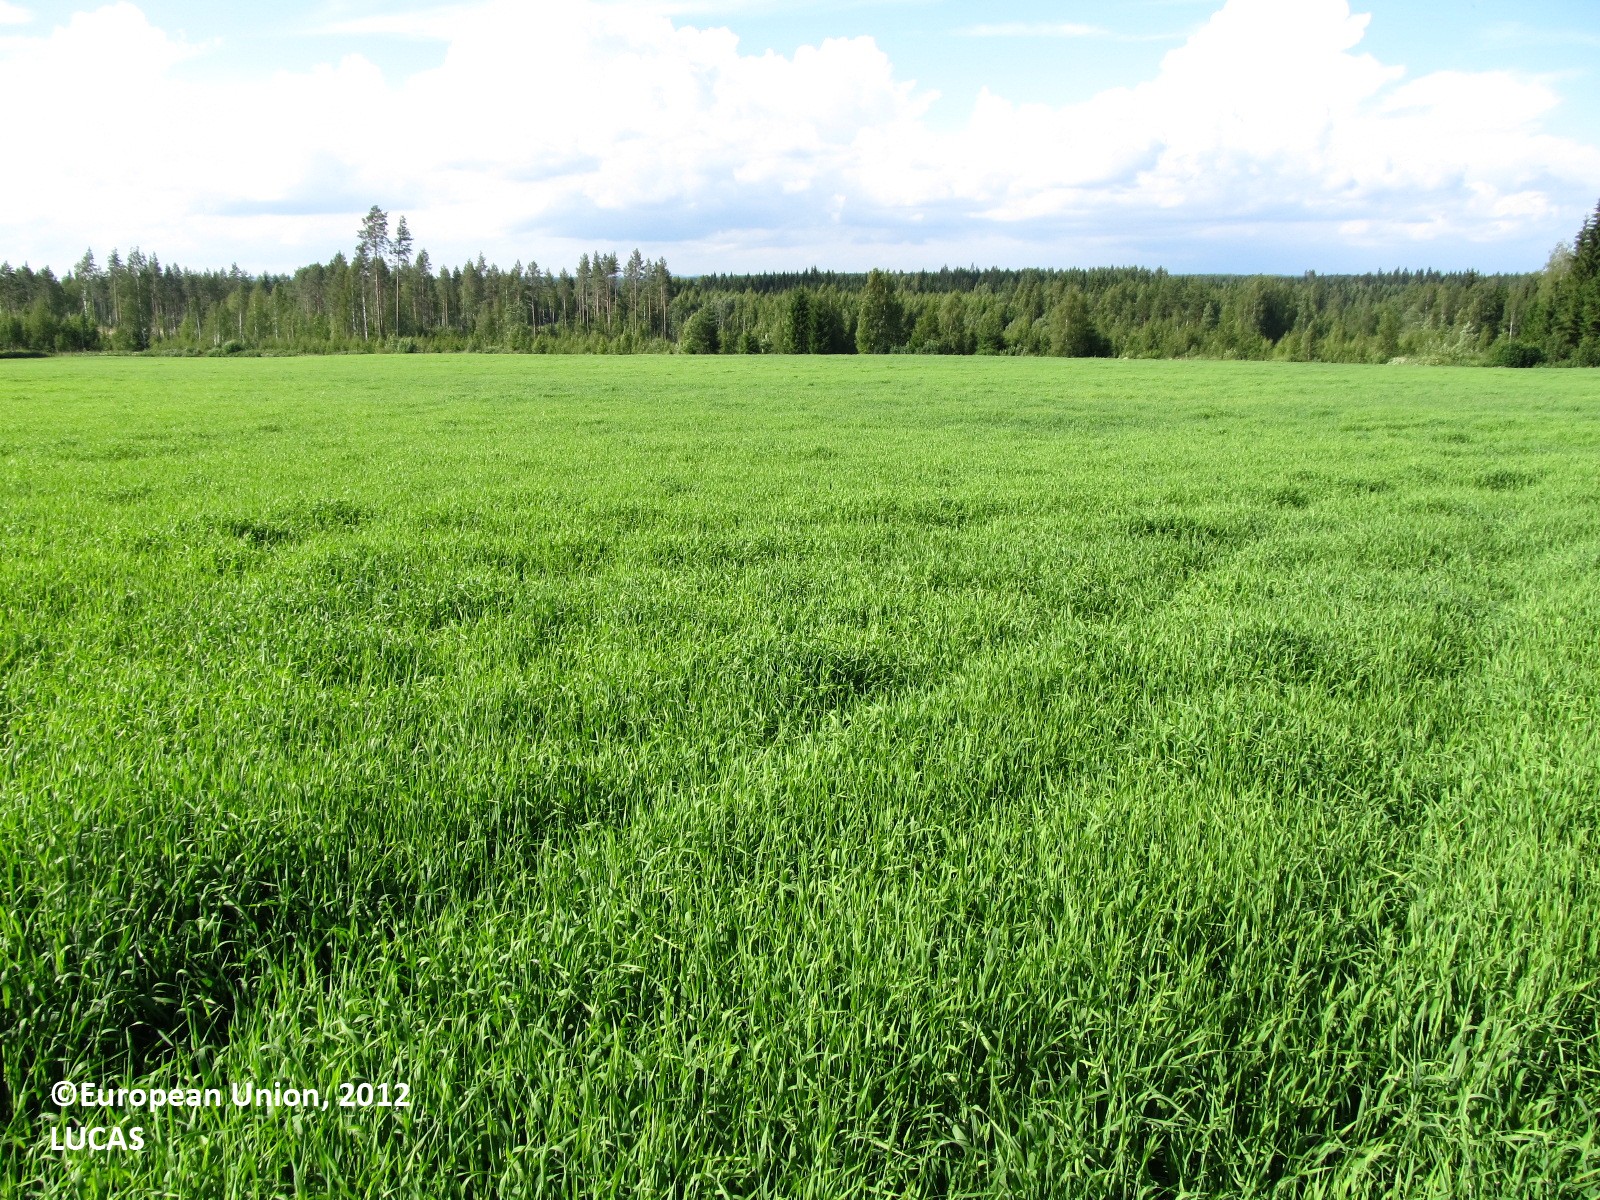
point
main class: Cropland
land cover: Barley
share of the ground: 50 - 75 %
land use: Agriculture (excluding fallow land and kitchen gardens)
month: July
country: FI
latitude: 61.9576
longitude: 28.4528
